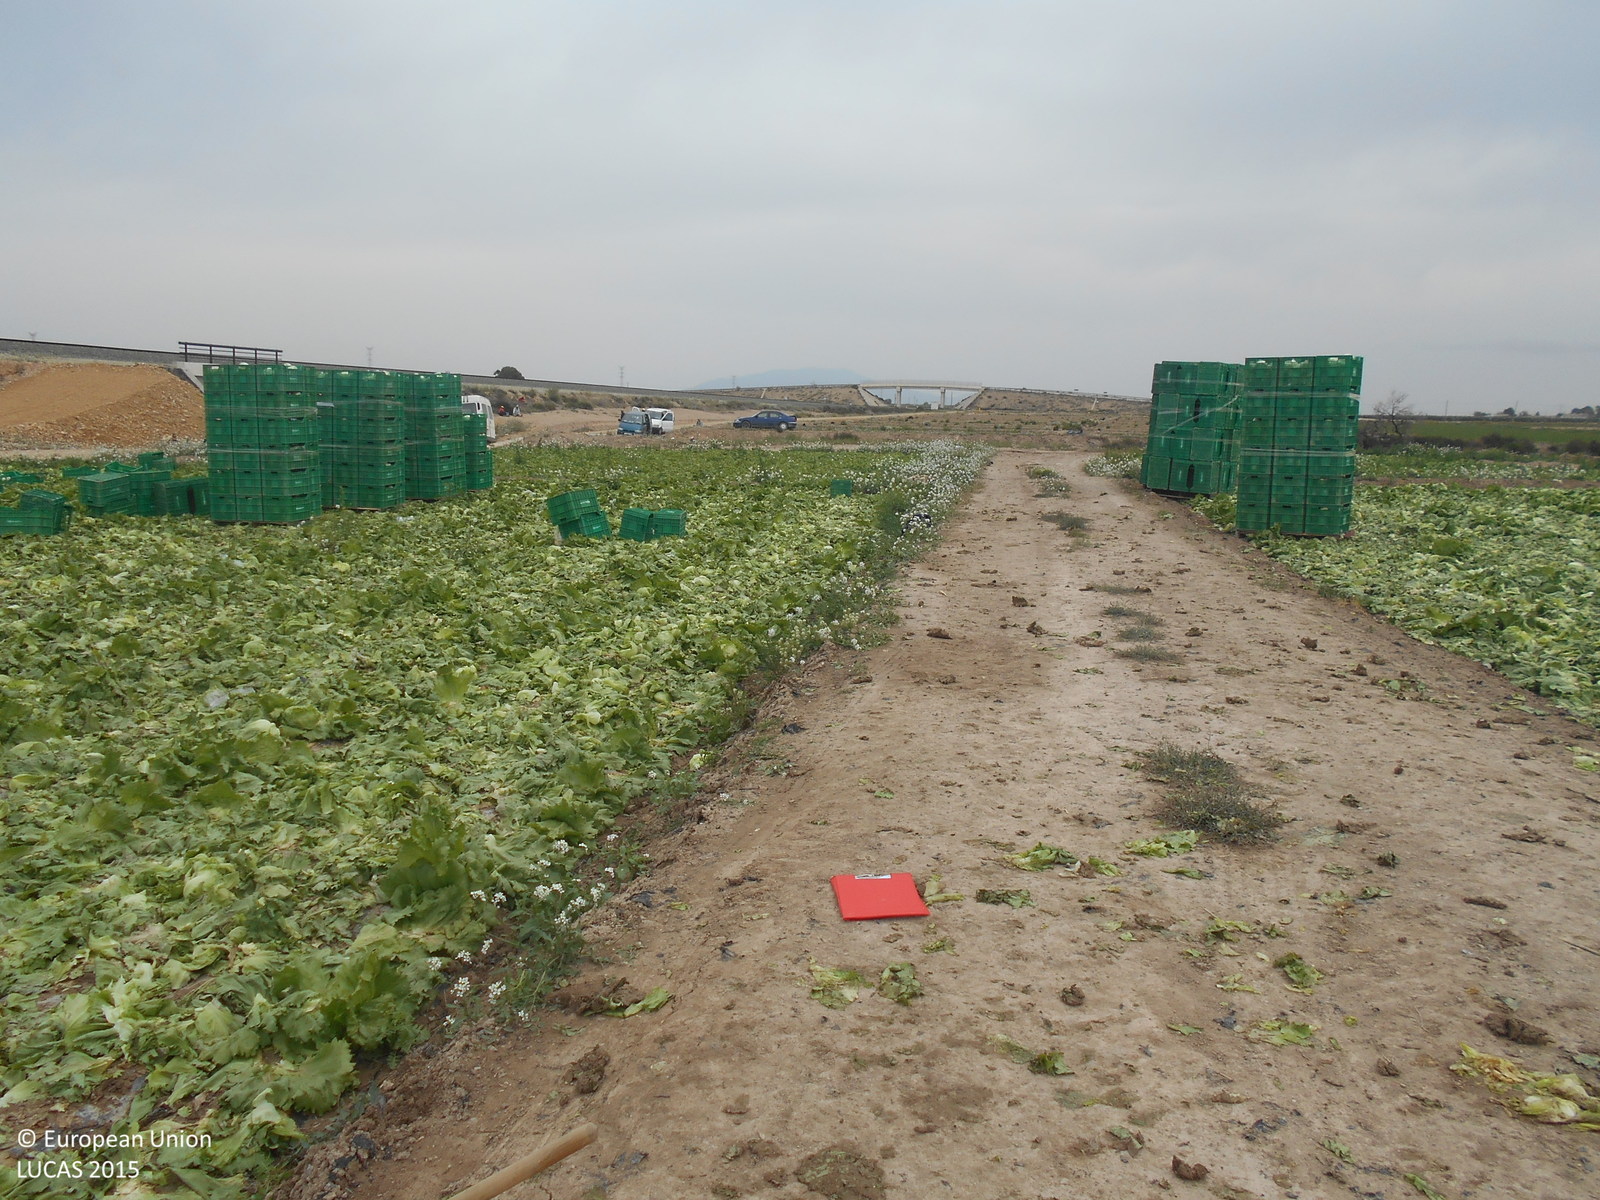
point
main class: Cropland
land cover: Other fresh vegetables
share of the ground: > 75 %
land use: Agriculture (excluding fallow land and kitchen gardens)
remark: Harvested field
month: April
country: ES
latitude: 37.7193
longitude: -1.5428
